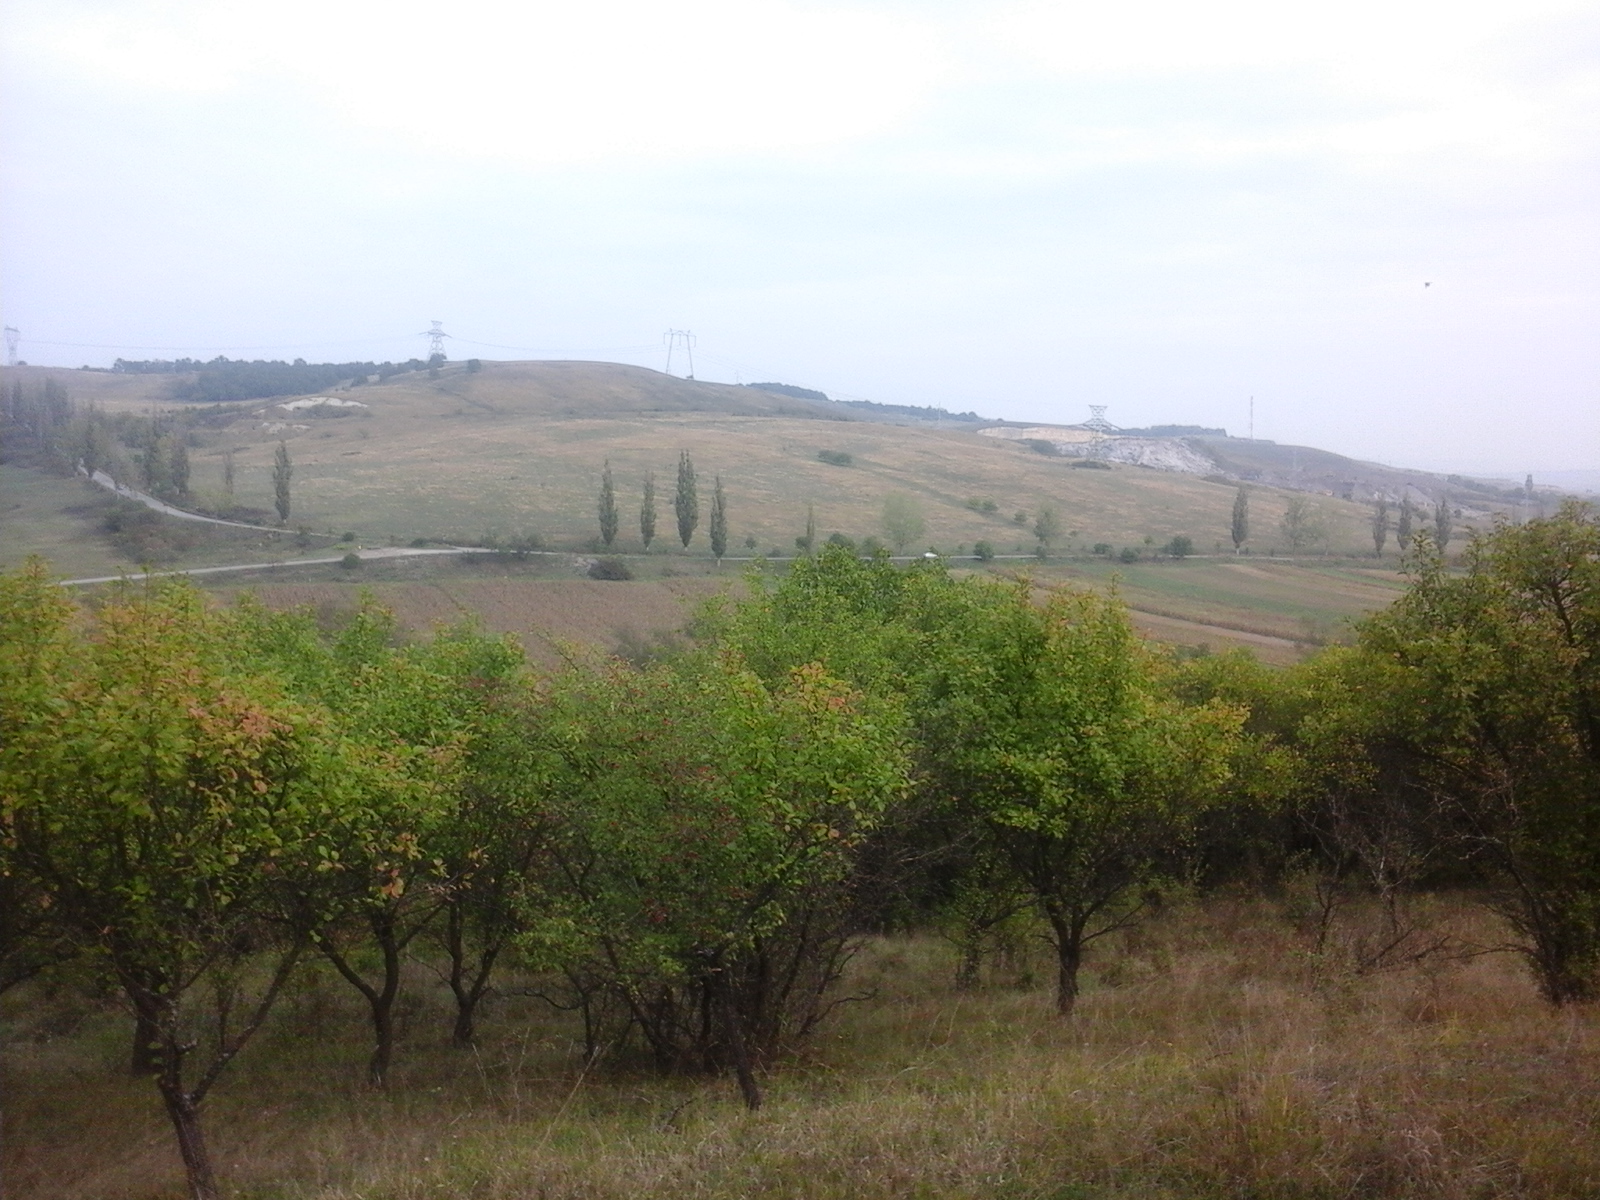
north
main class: Cropland
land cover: Other fruit trees and berries
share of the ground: > 75 %
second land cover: Grassland without tree/shrub cover
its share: > 75 %
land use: Agriculture (excluding fallow land and kitchen gardens)
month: September
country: RO
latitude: 45.7222
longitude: 22.9663
